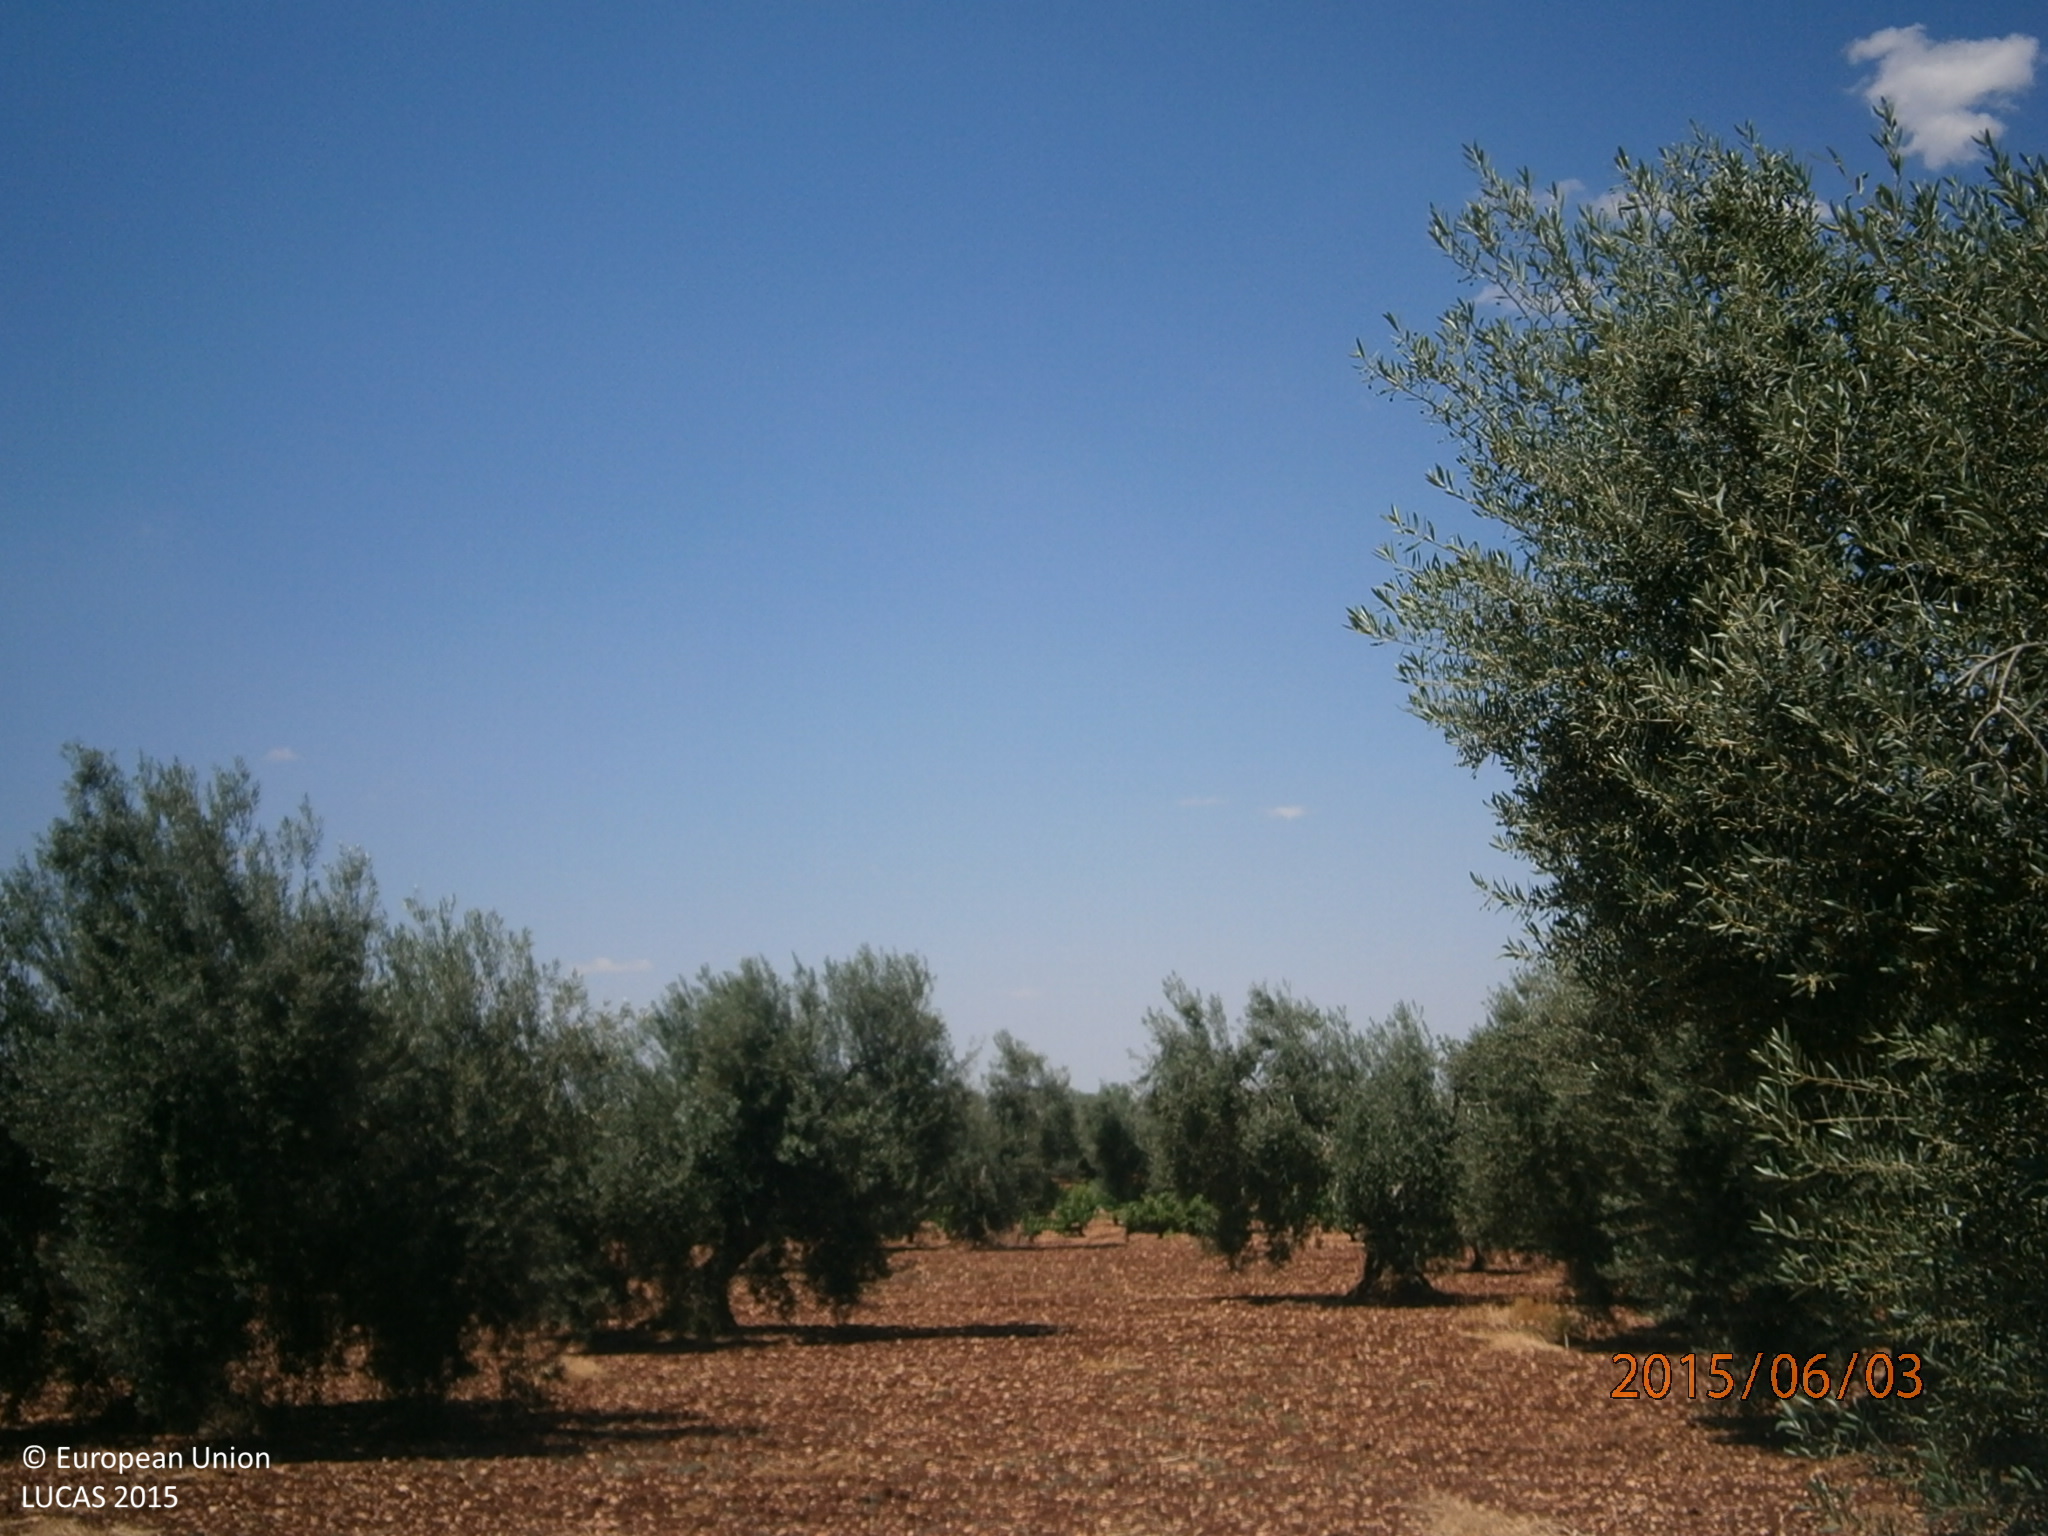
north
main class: Cropland
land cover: Olive groves
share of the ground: 10 - 25 %
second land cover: Other bare soil
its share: > 75 %
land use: Agriculture (excluding fallow land and kitchen gardens)
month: June
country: ES
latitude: 38.6192
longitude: -6.3971
